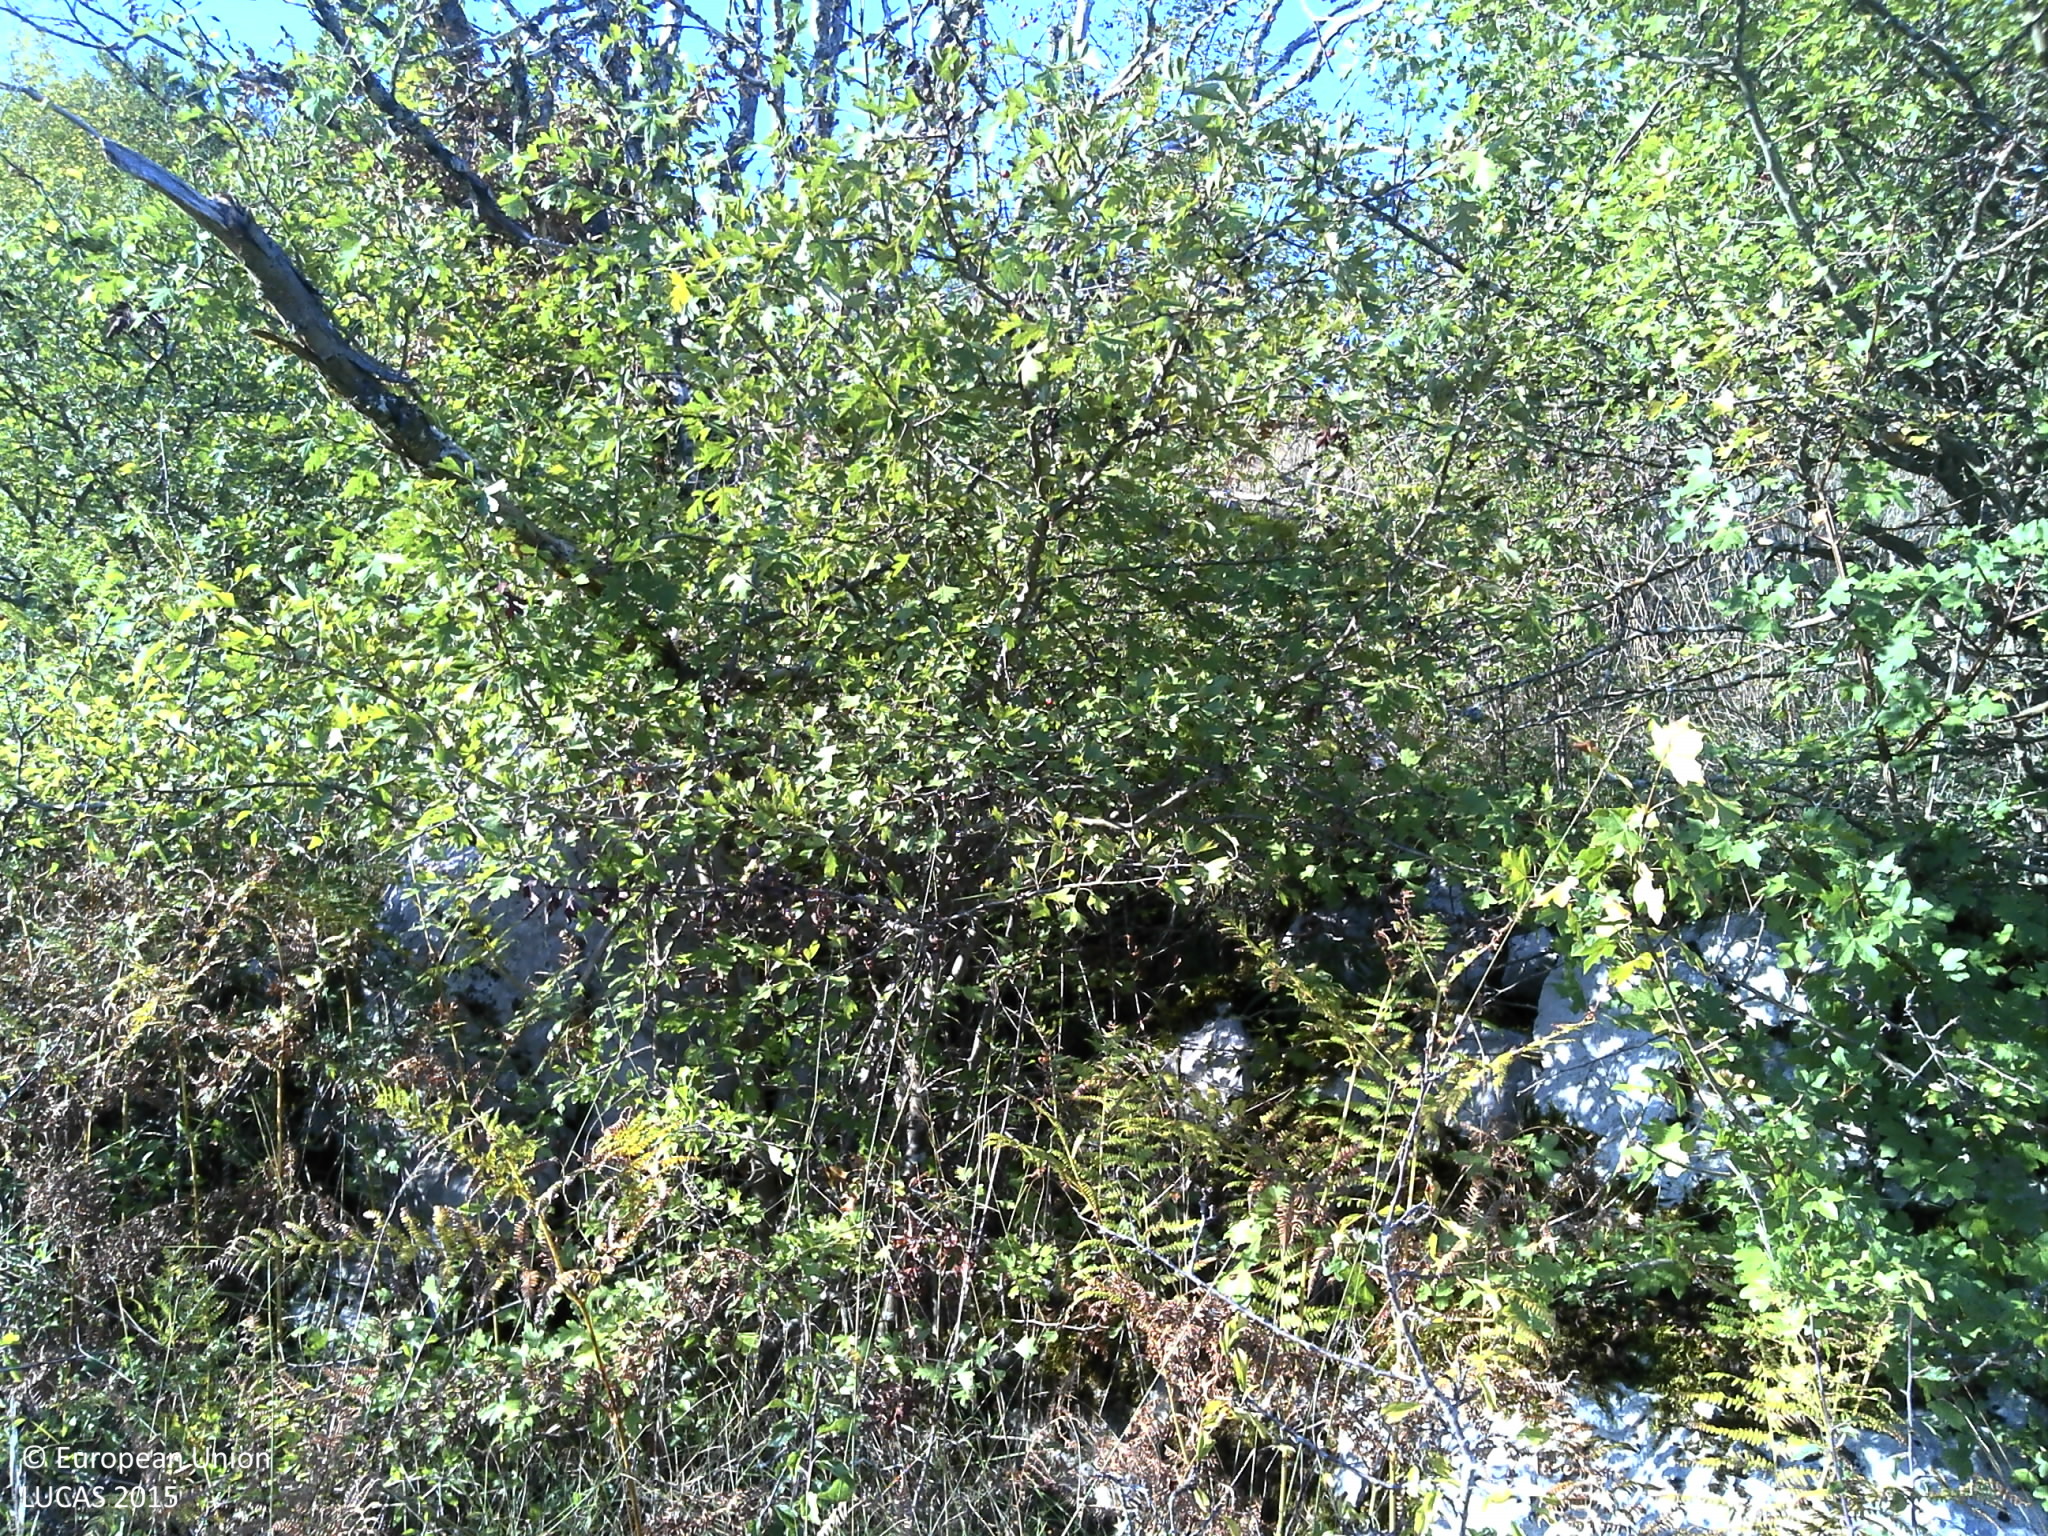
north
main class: Shrubland
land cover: Shrubland with sparse tree cover
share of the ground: > 75 %
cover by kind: shrubs 75 %, herbaceous plants 20 %, broadleaved forest trees 5 %
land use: Semi-natural and natural areas not in use
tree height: < 5 m
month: August
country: HR
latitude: 45.1095
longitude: 15.1169
